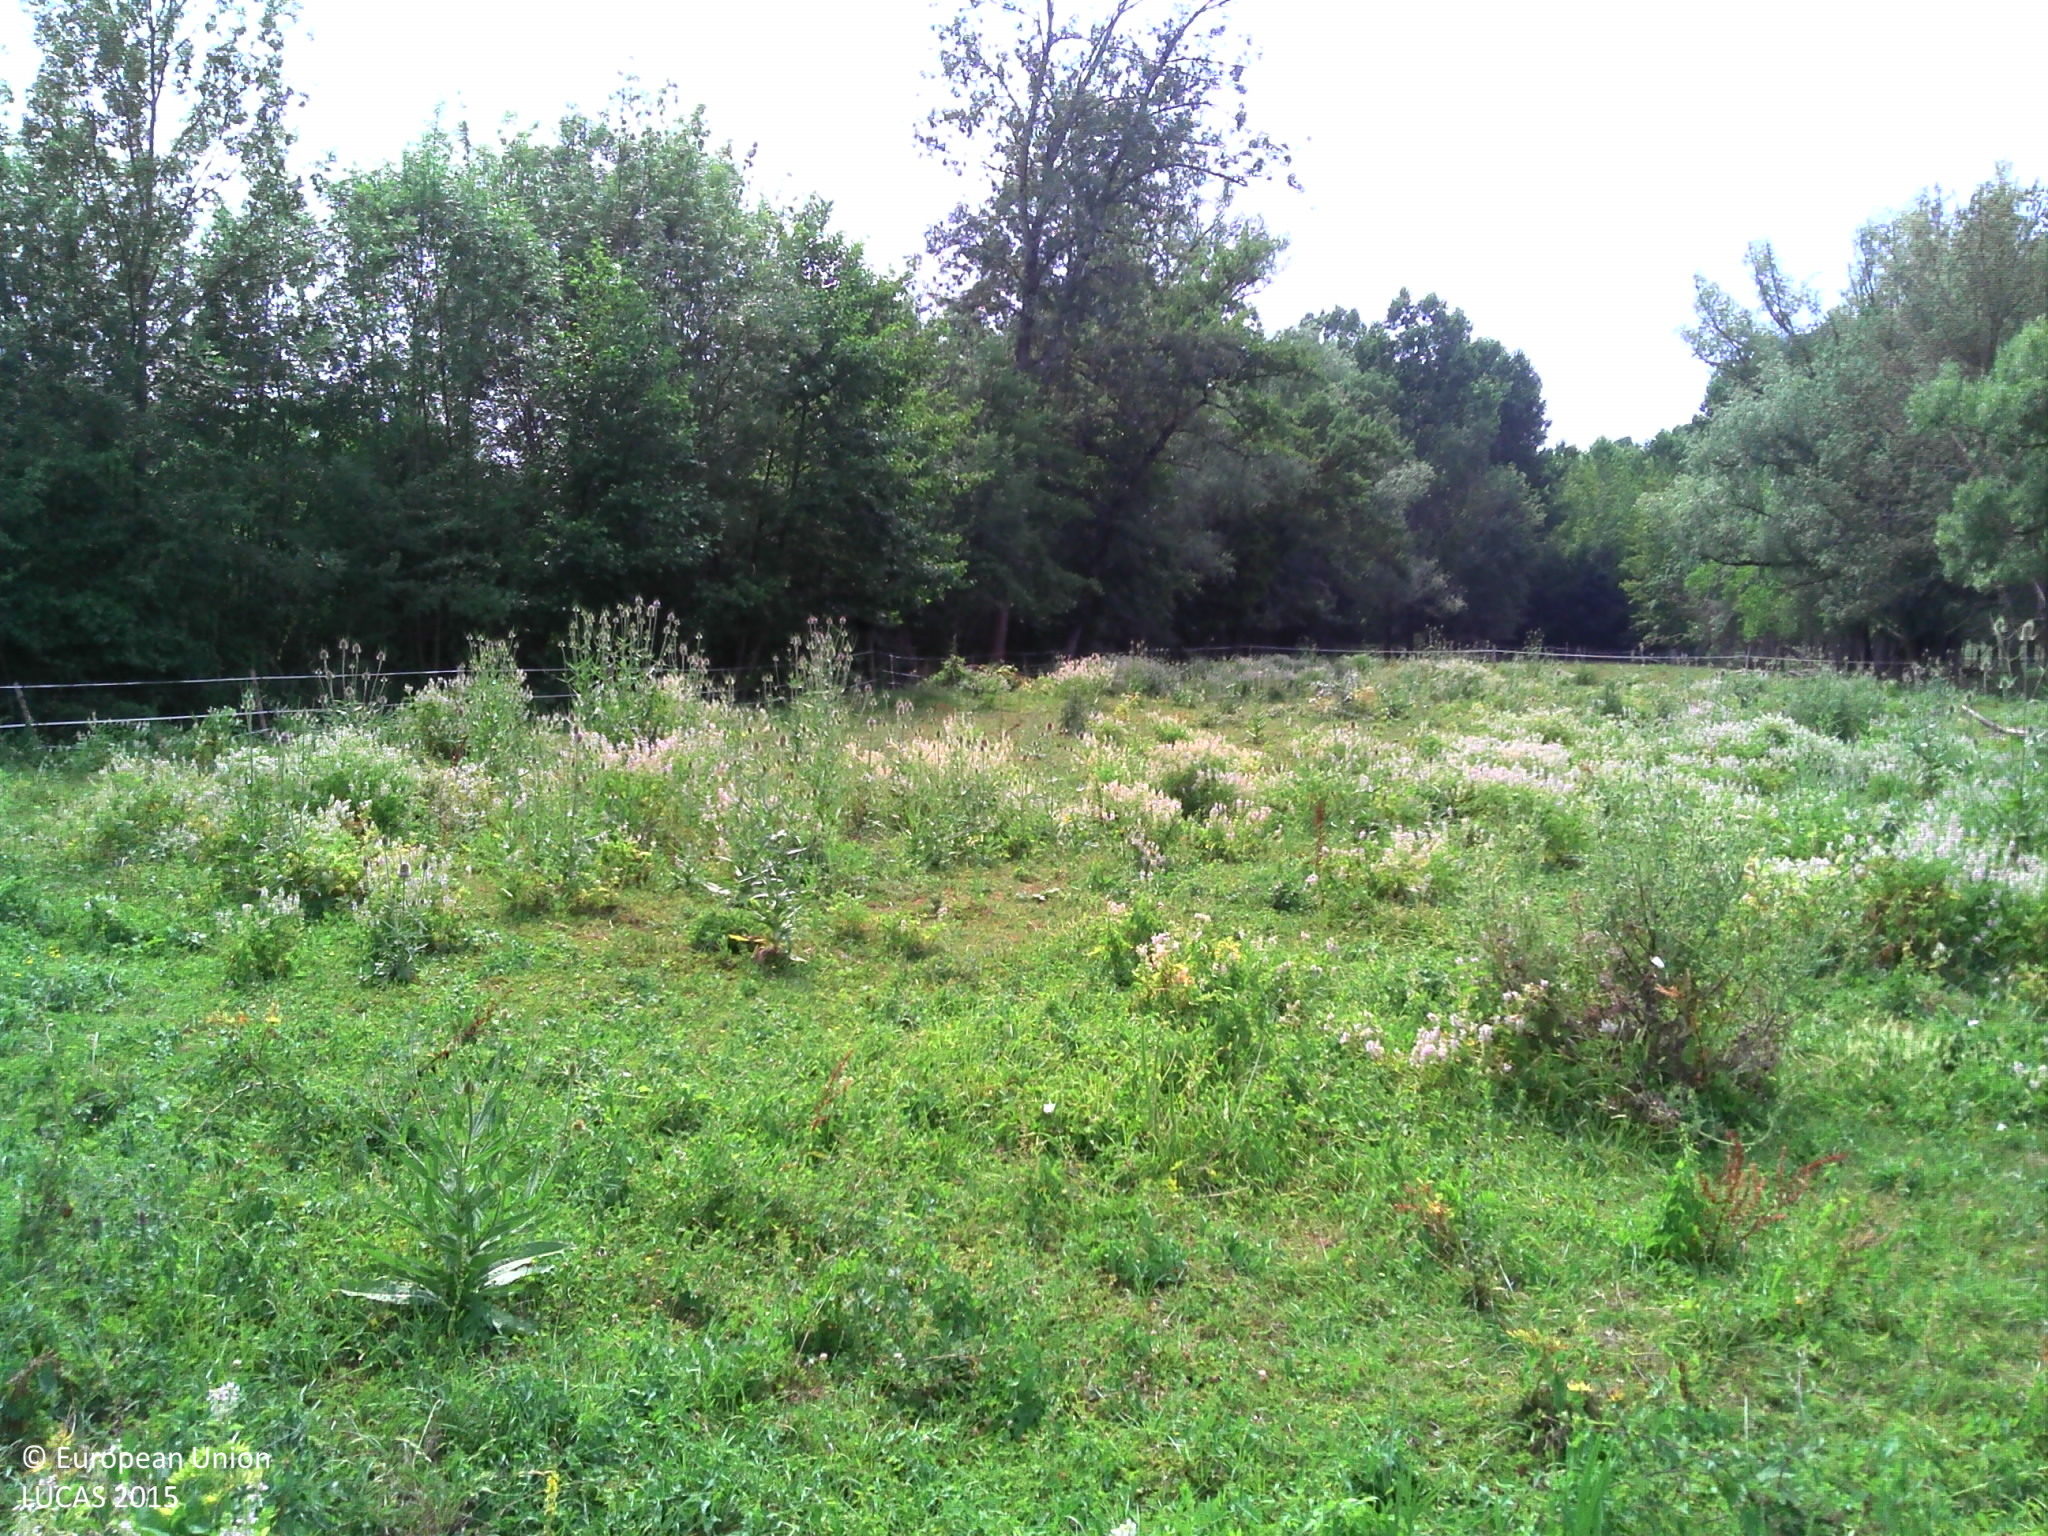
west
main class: Grassland
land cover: Grassland with sparse tree/shrub cover
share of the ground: > 75 %
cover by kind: herbaceous plants 95 %, broadleaved forest trees 5 %
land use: Agriculture (excluding fallow land and kitchen gardens)
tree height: > 5 m
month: July
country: FR
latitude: 44.3805
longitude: 0.8452
